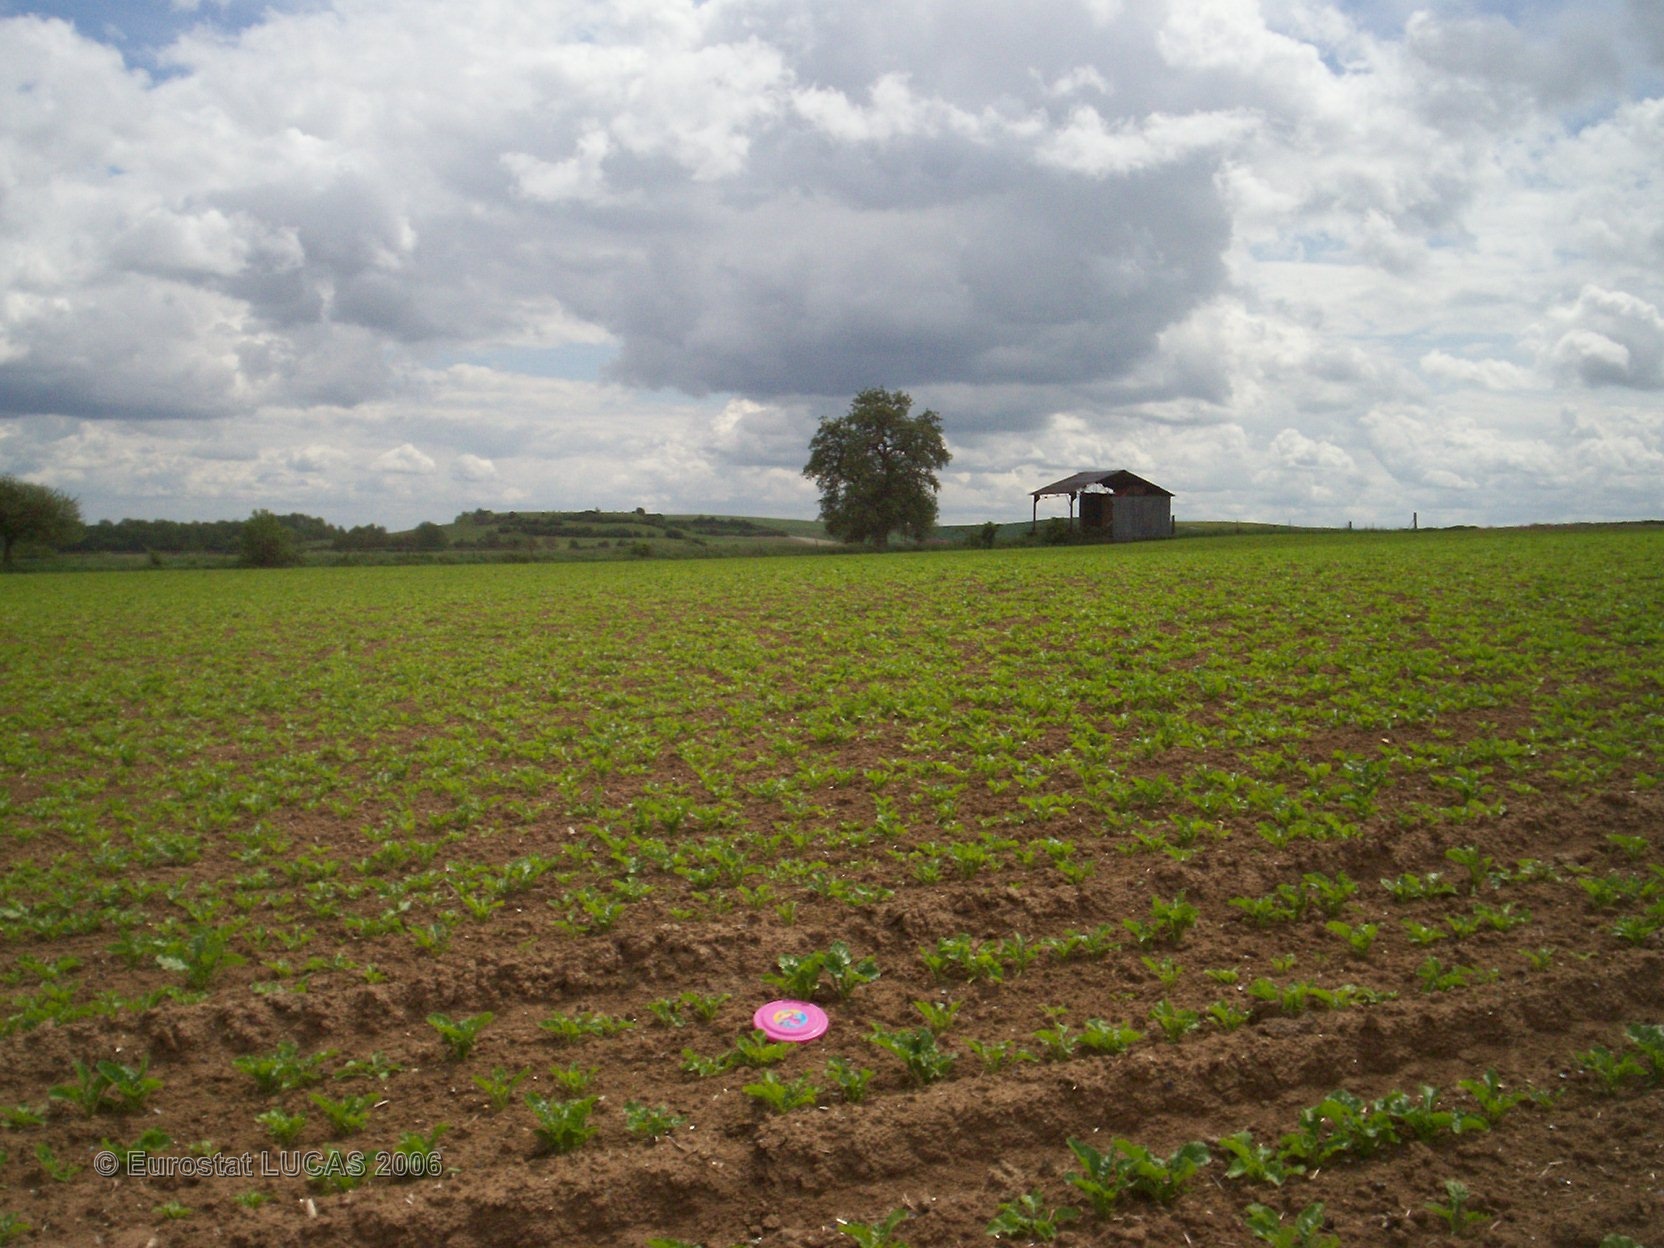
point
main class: Cropland
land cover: Sugar beet
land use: Agriculture (excluding fallow land and kitchen gardens)
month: May
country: FR
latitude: 49.5418
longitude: 4.3989
